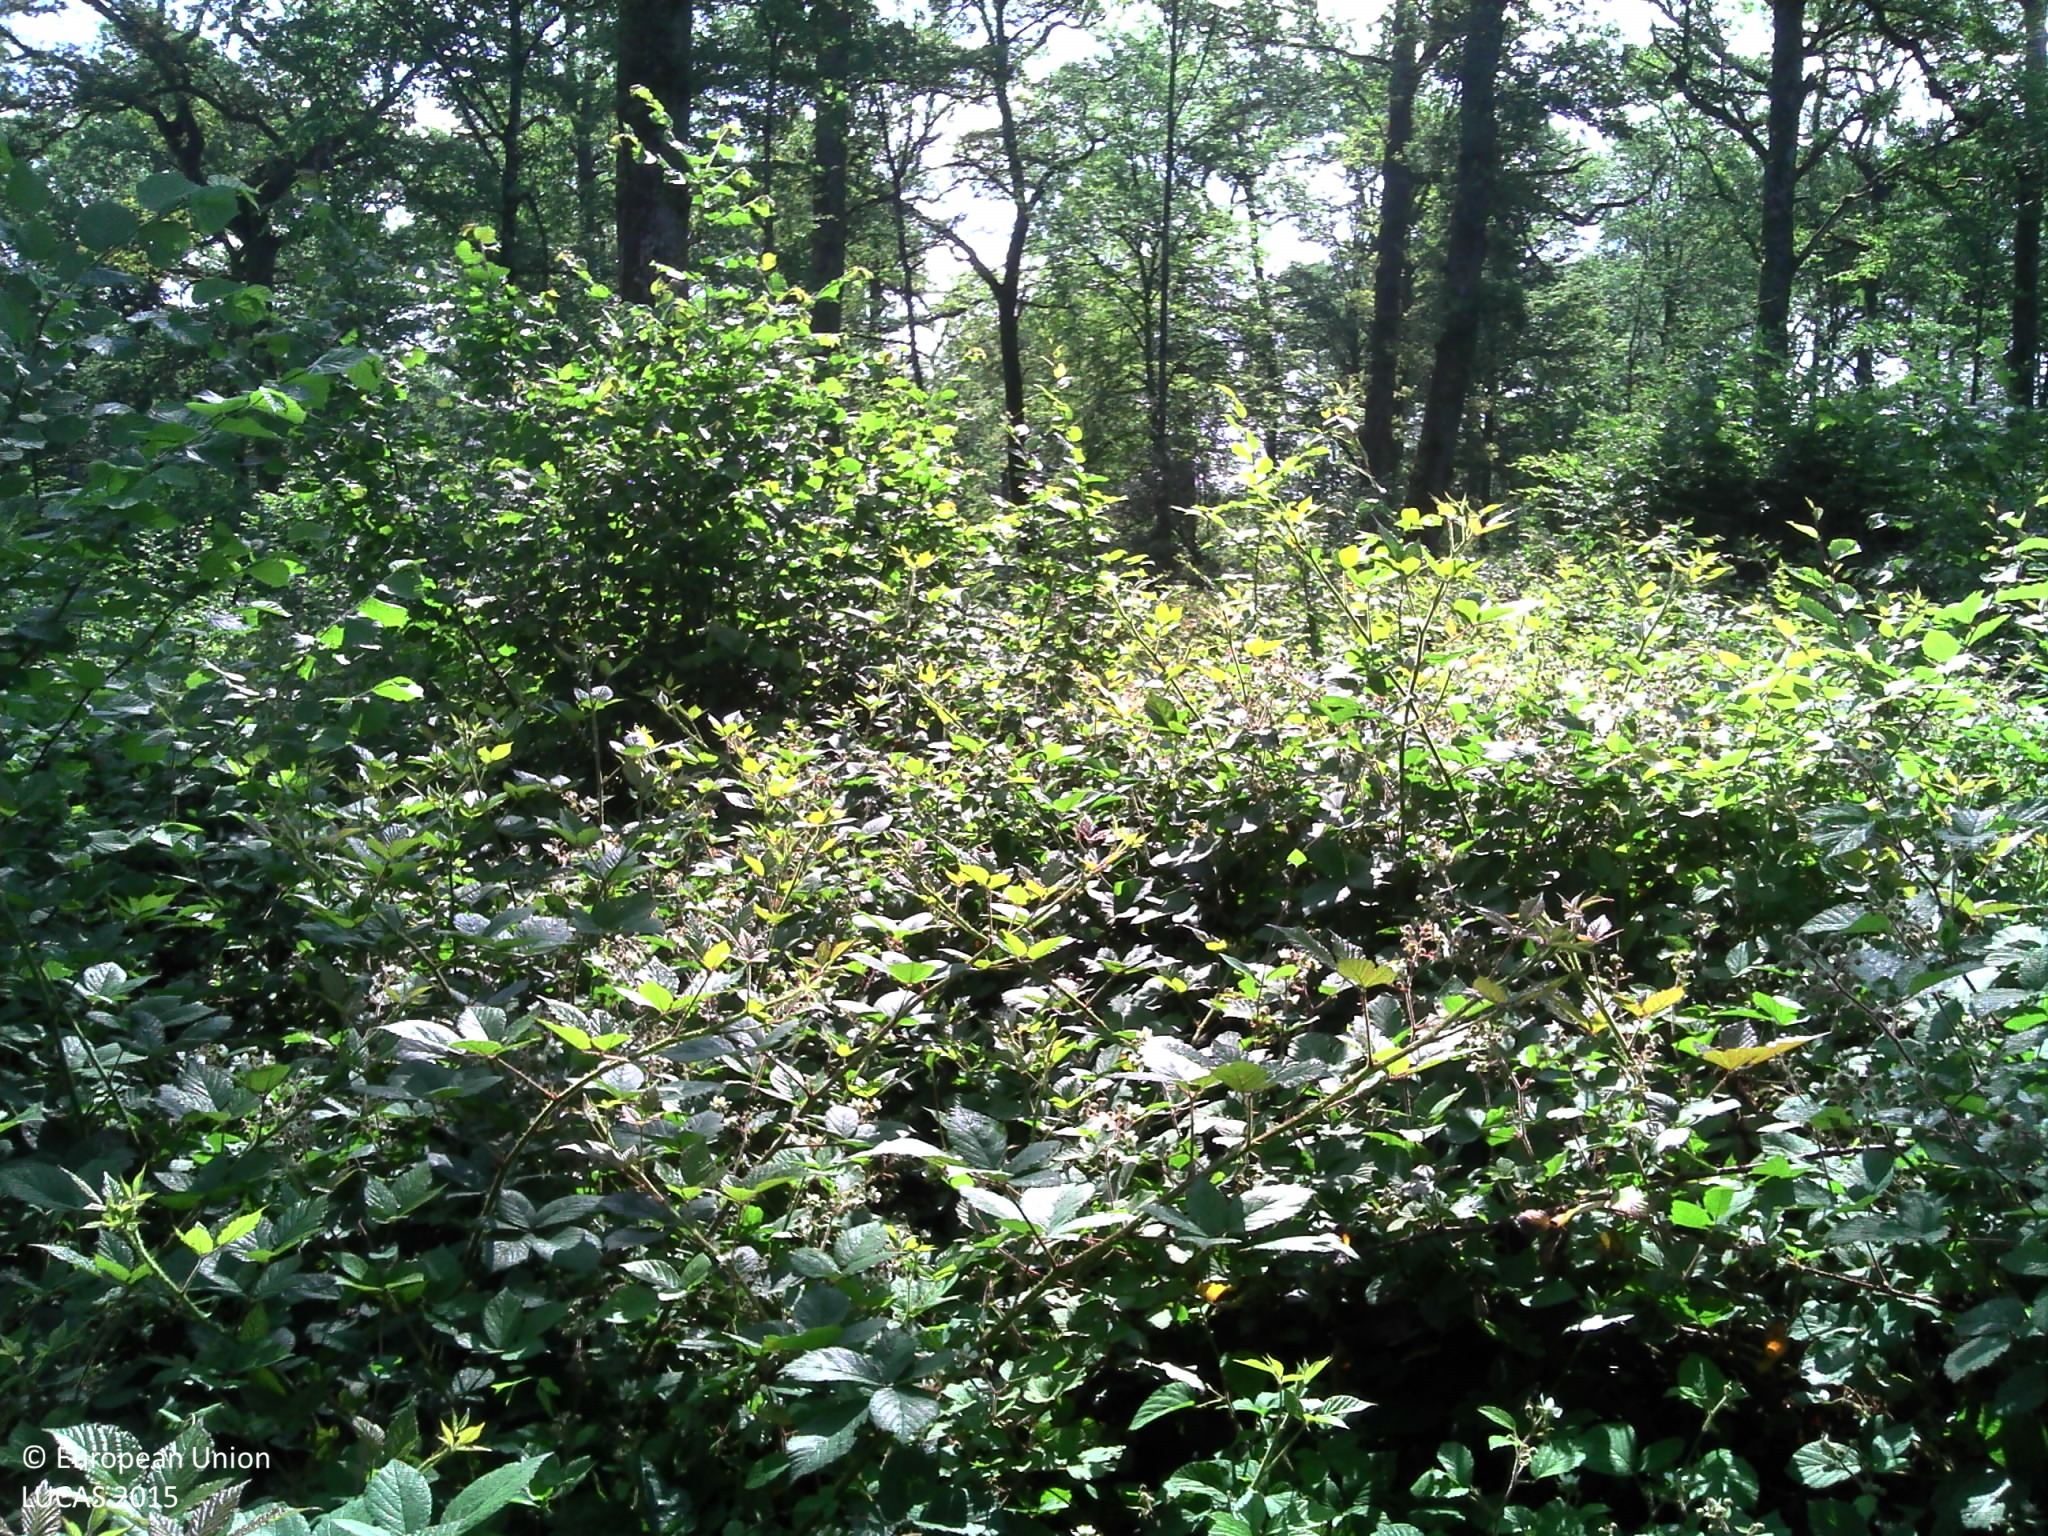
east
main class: Woodland
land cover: Broadleaved woodland
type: mesophytic deciduous forest
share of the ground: > 75 %
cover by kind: broadleaved forest trees 90 %, herbaceous plants 5 %, lichens and mosses 5 %
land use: Forestry
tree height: > 5 m
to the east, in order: Broadleaved woodland; Tracks; Broadleaved woodland; Ditches and canals; Fences; Grassland without tree/shrub cover; Abandoned hedges; Fences; Grassland without tree/shrub cover
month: June
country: FR
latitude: 47.4266
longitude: 3.9660
